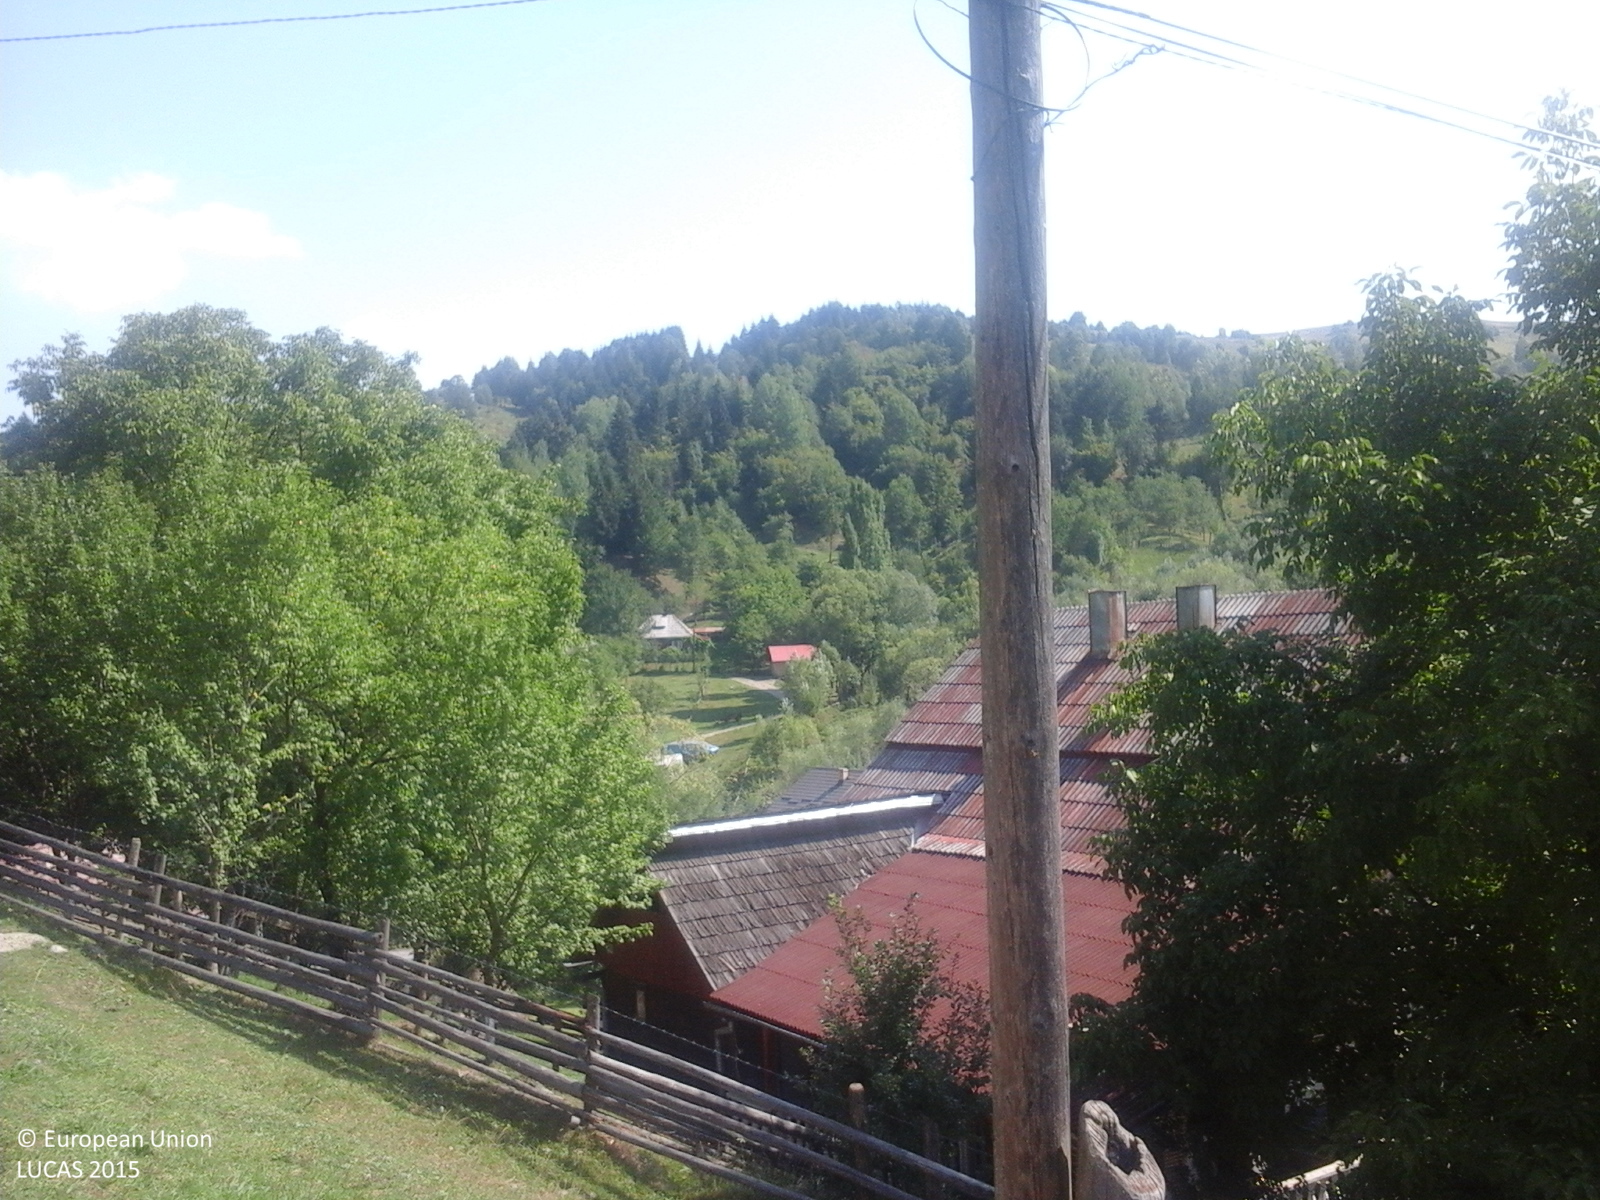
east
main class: Grassland
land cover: Grassland without tree/shrub cover
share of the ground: > 75 %
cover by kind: herbaceous plants 100 %
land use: Agriculture (excluding fallow land and kitchen gardens)
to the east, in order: Grassland without tree/shrub cover; Artificial constructions in urban areas; Grassland without tree/shrub cover; Shrubland with sparse tree cover; Grassland without tree/shrub cover; Grassland with sparse tree/shrub cover
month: September
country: RO
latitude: 47.6373
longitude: 24.6723
